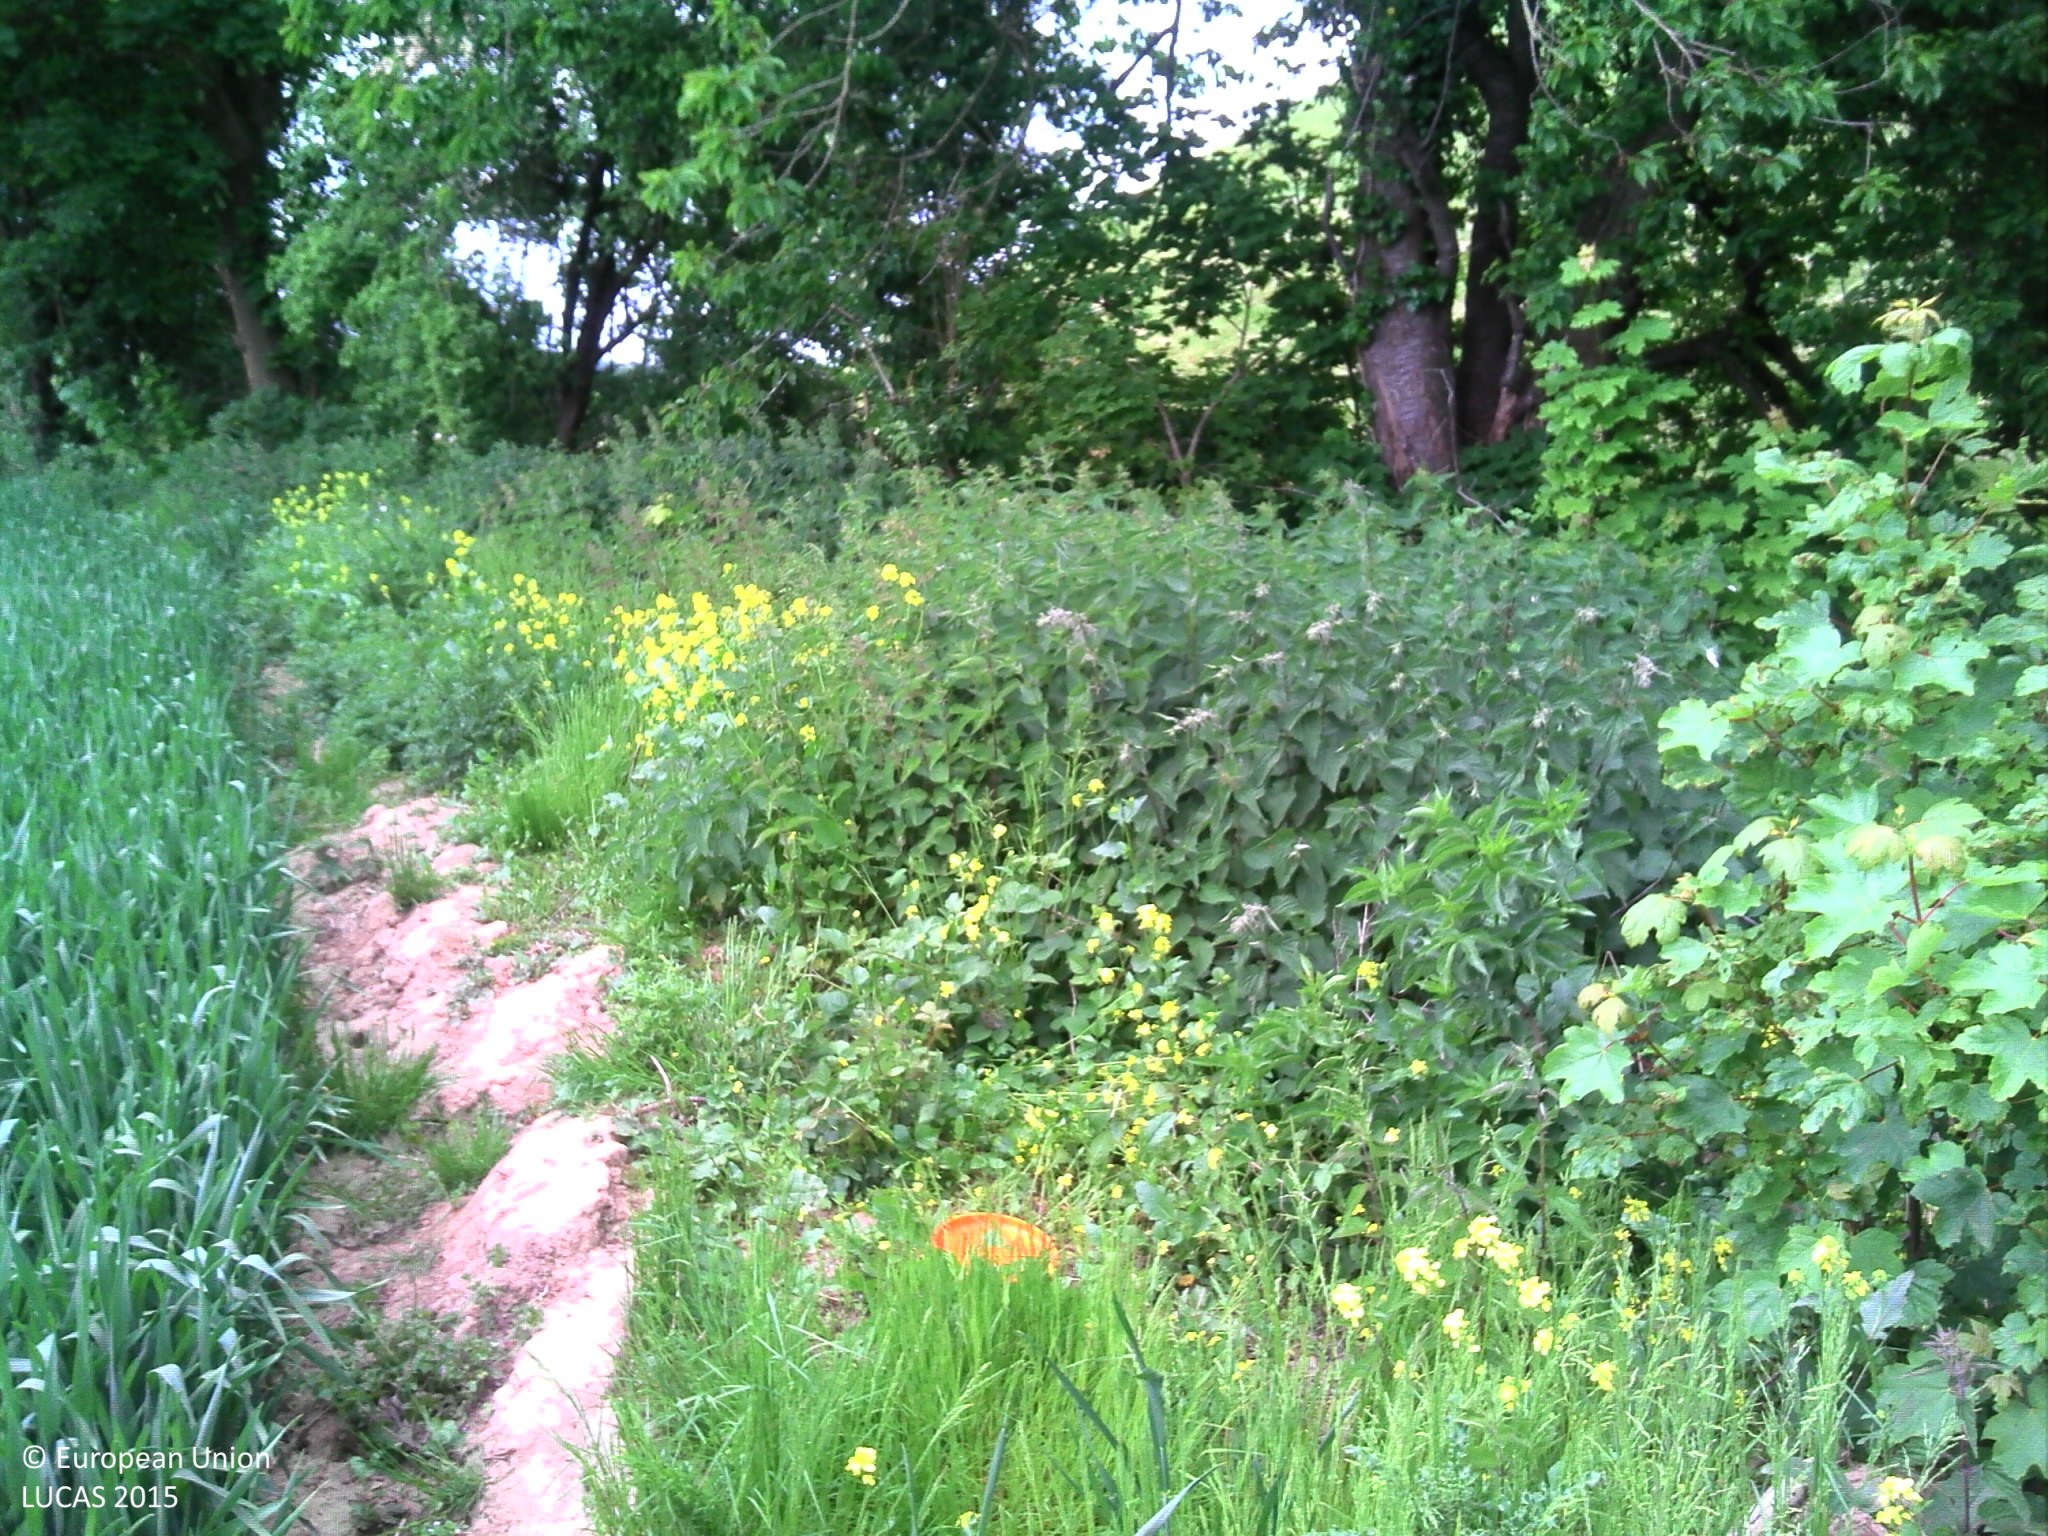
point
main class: Woodland
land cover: Broadleaved woodland
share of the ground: > 75 %
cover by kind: broadleaved forest trees 100 %
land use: Amenities, museums, leisure
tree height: > 5 m
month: May
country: BE
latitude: 50.6778
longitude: 4.4056
